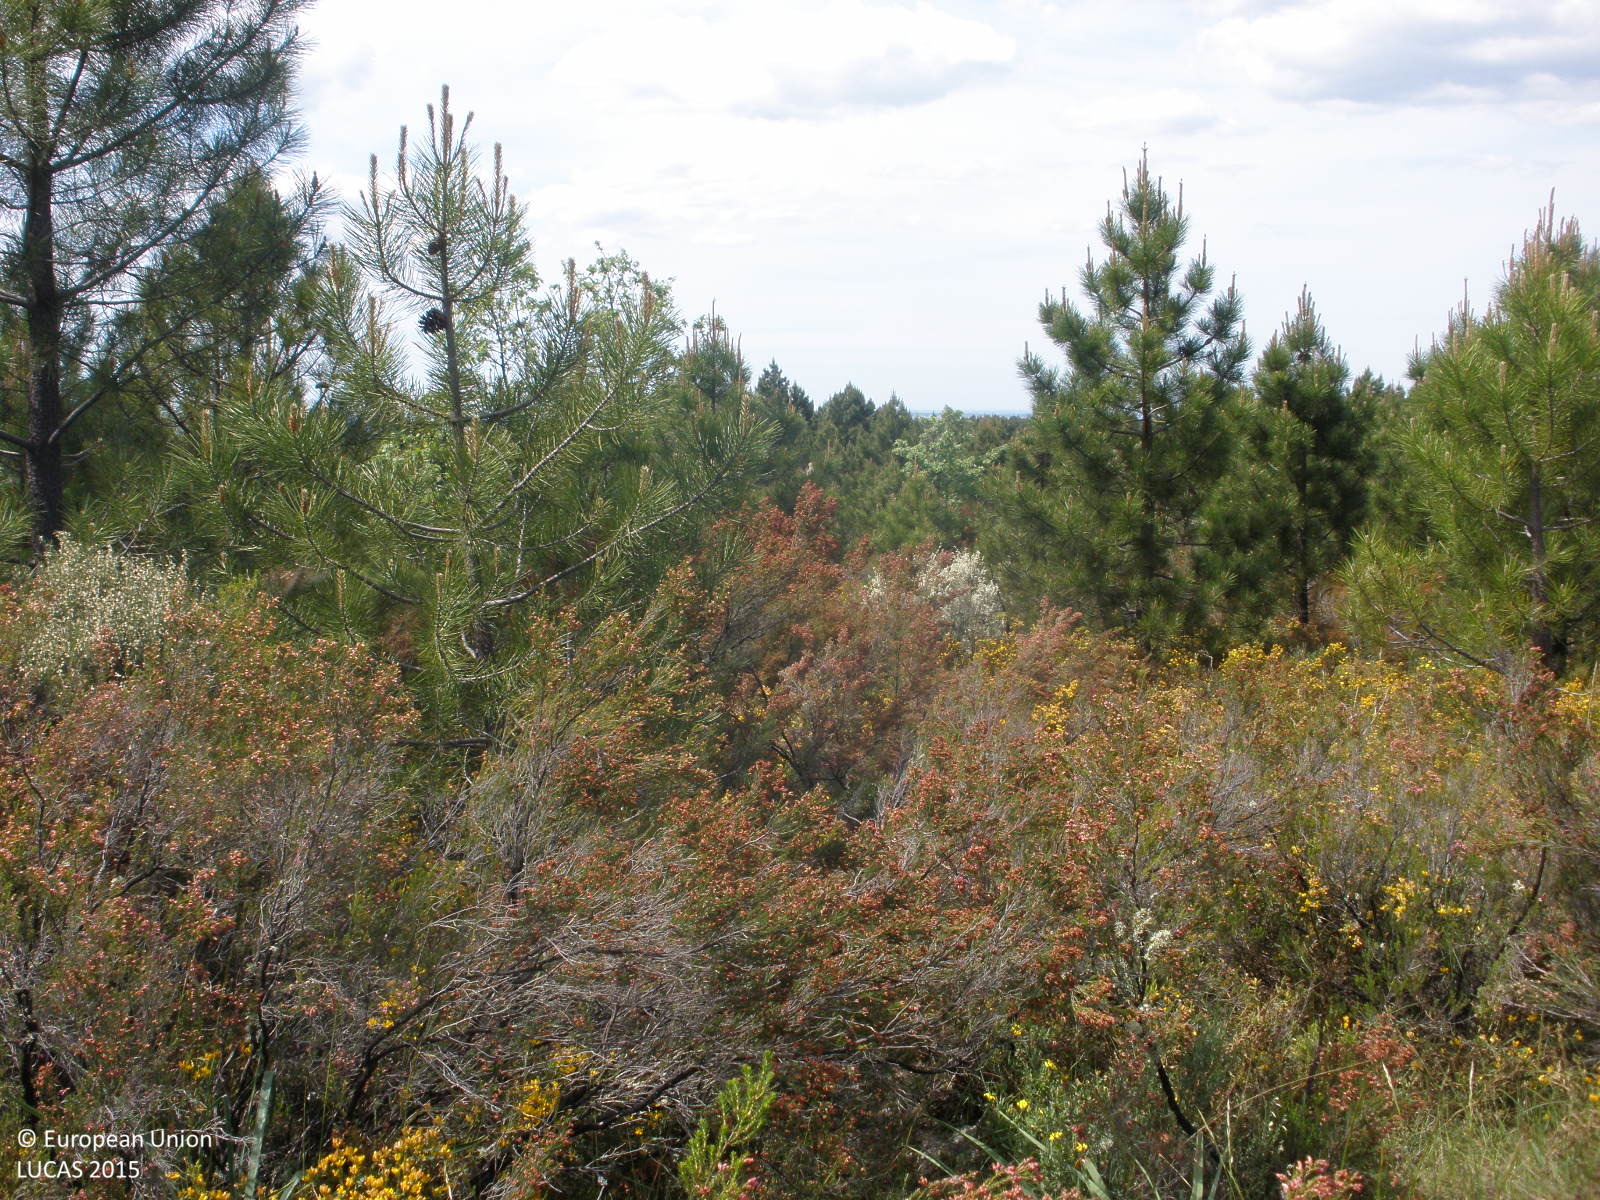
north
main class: Woodland
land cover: Pine dominated coniferous woodland
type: coniferous forest of the mediterranean region
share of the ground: > 75 %
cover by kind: shrubs 60 %, coniferous forest trees 40 %
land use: Forestry
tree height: < 5 m
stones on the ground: > 50 %
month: May
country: ES
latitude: 40.2771
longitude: -6.6105
